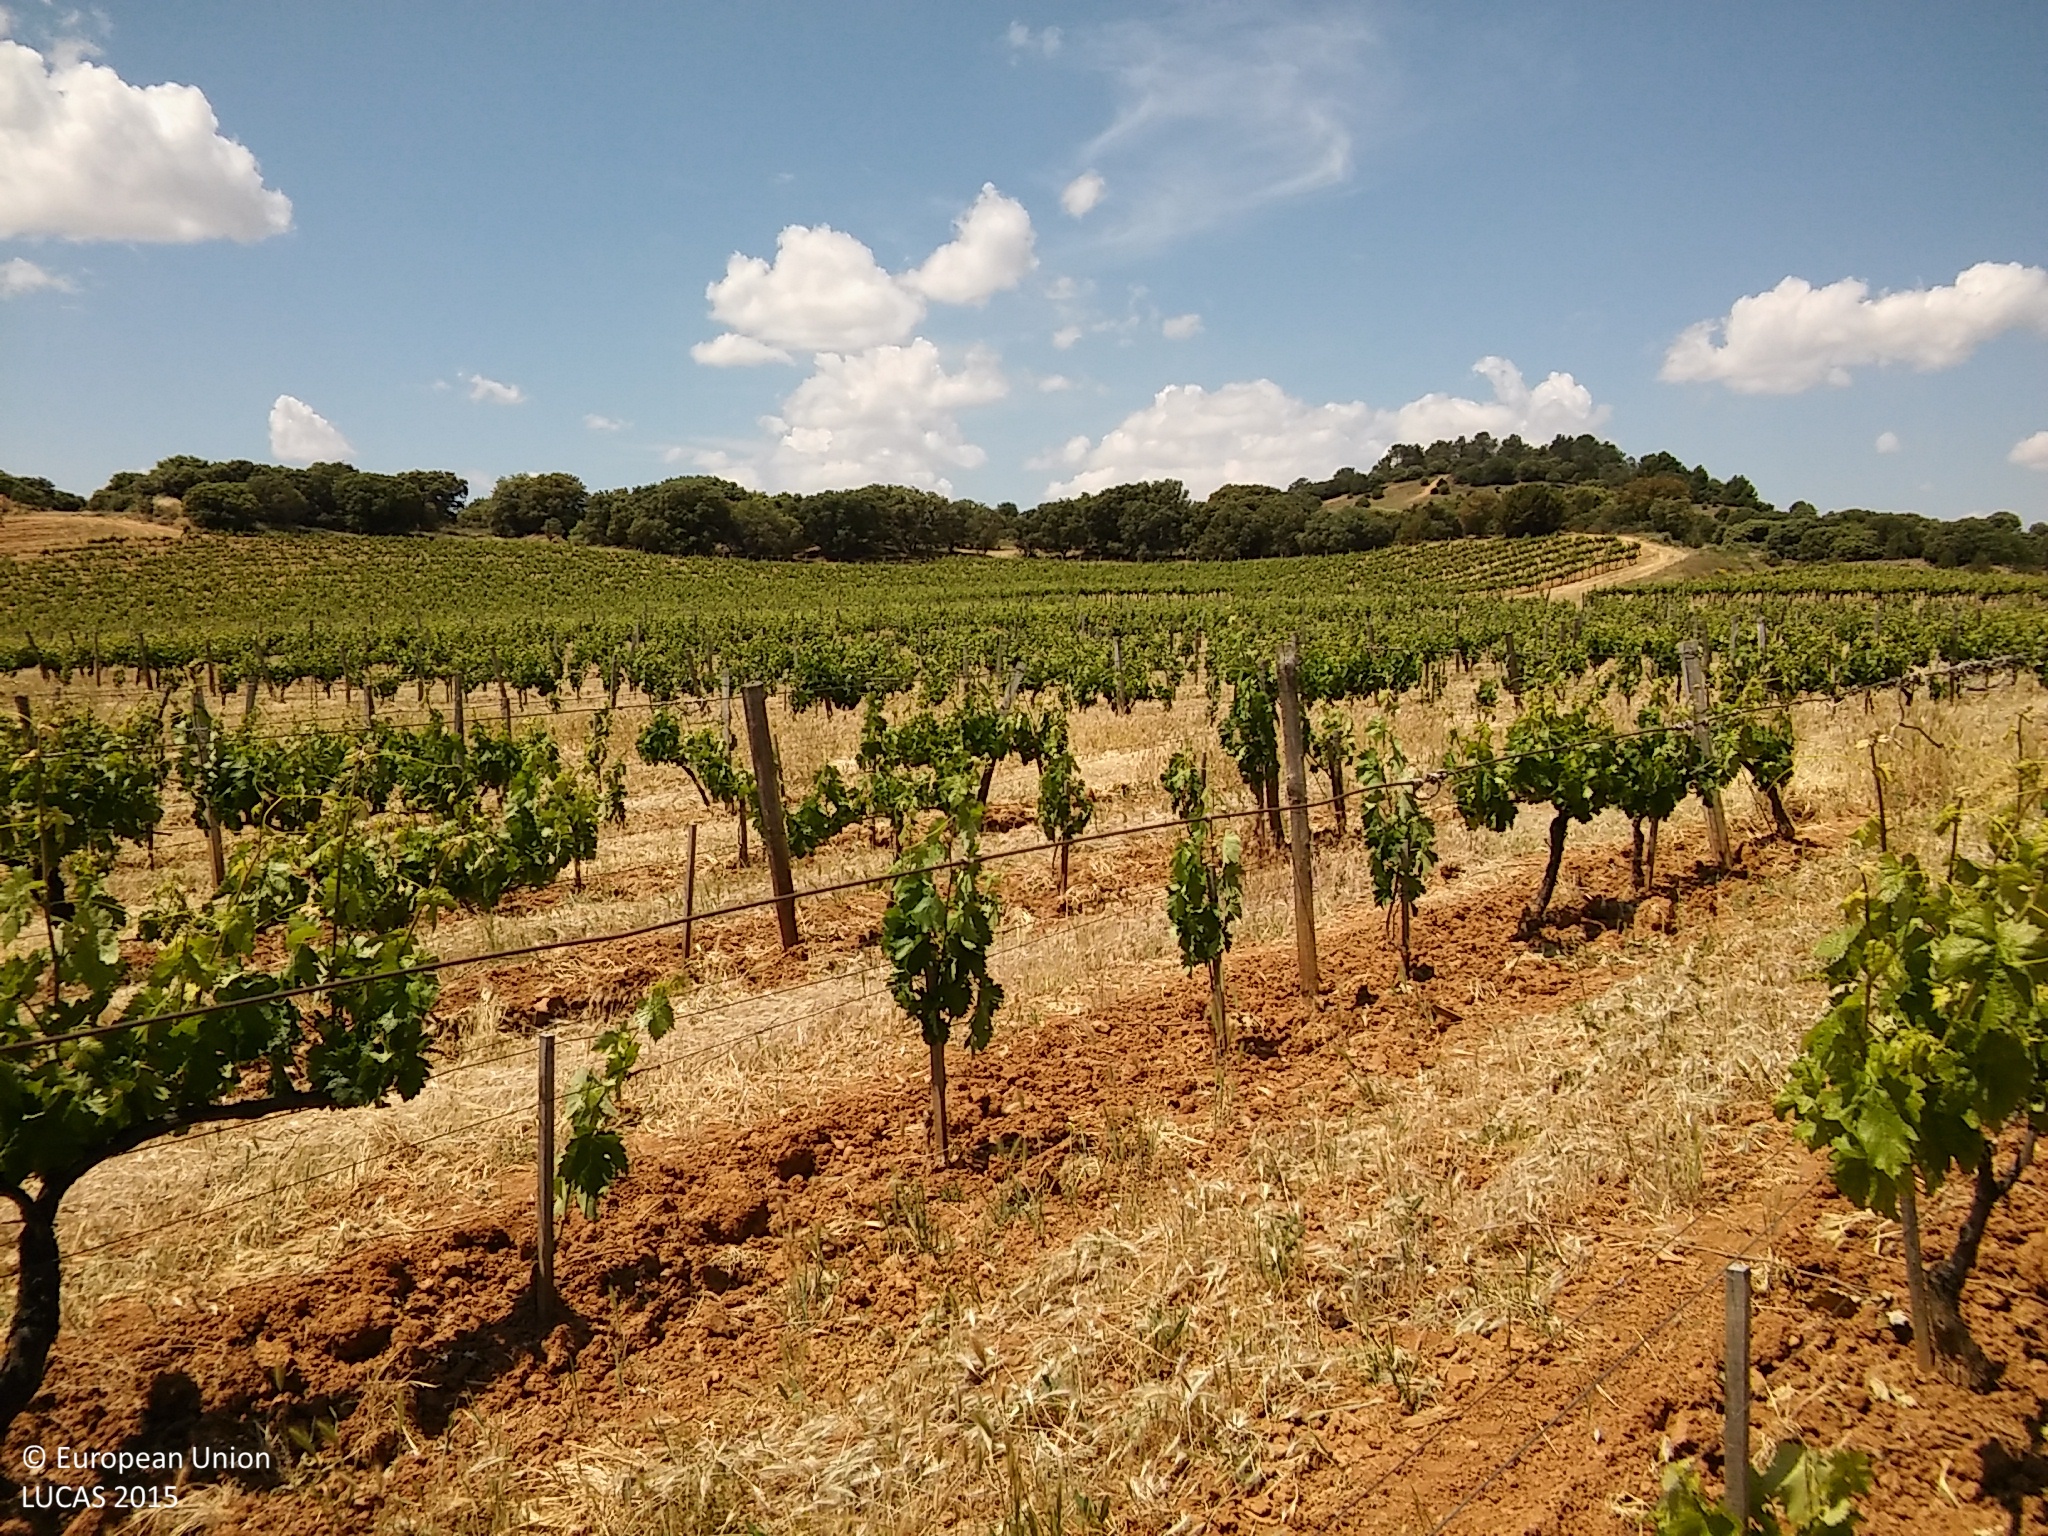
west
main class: Cropland
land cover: Vineyards
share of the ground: 10 - 25 %
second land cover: Other bare soil
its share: > 75 %
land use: Agriculture (excluding fallow land and kitchen gardens)
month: June
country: ES
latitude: 41.6412
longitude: -3.7274
